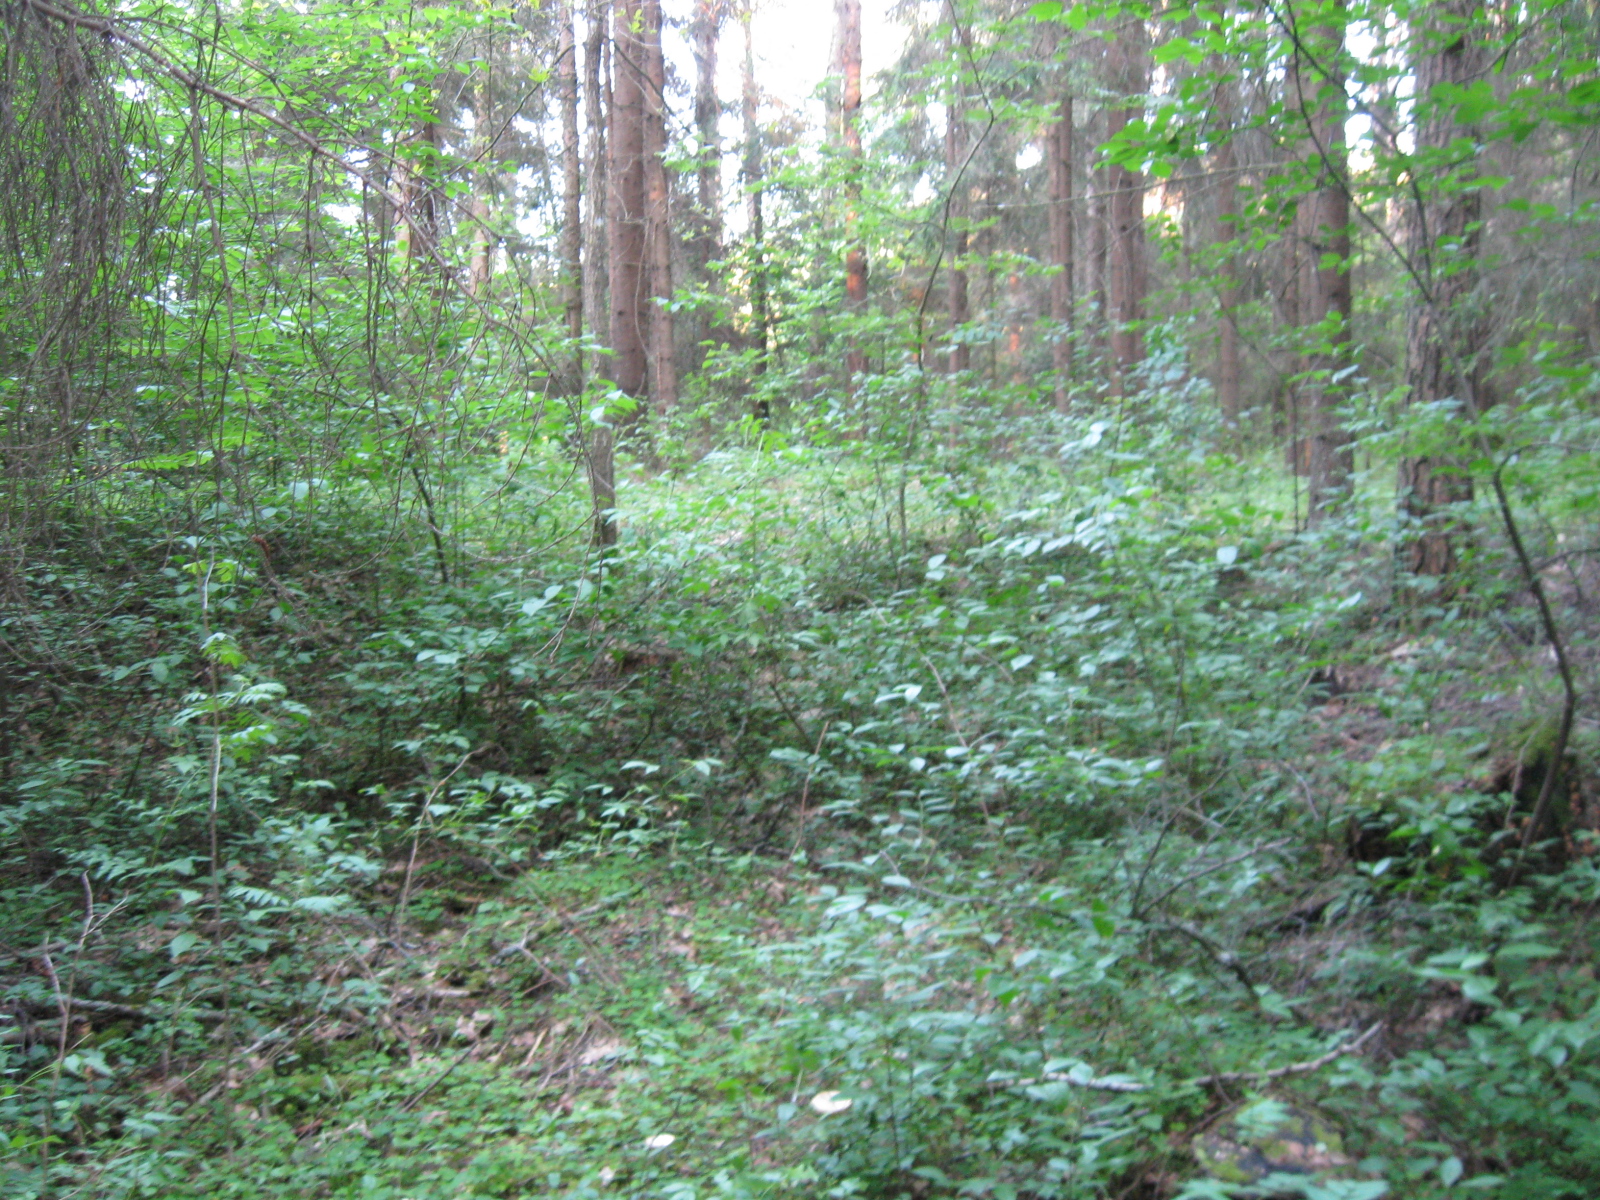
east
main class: Woodland
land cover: Spruce dominated mixed woodland
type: hemiboreal forest and nemoral coniferous forest and mixed broadleaved-coniferous forest
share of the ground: > 75 %
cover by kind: coniferous forest trees 70 %, broadleaved forest trees 30 %
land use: Forestry
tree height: > 5 m
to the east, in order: Spruce dominated mixed woodland; Pine dominated coniferous woodland; Other mixed woodland; Grassland without tree/shrub cover; Tracks; Pine dominated mixed woodland; Grass margins
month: June
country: LT
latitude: 54.1518
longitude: 23.6984
